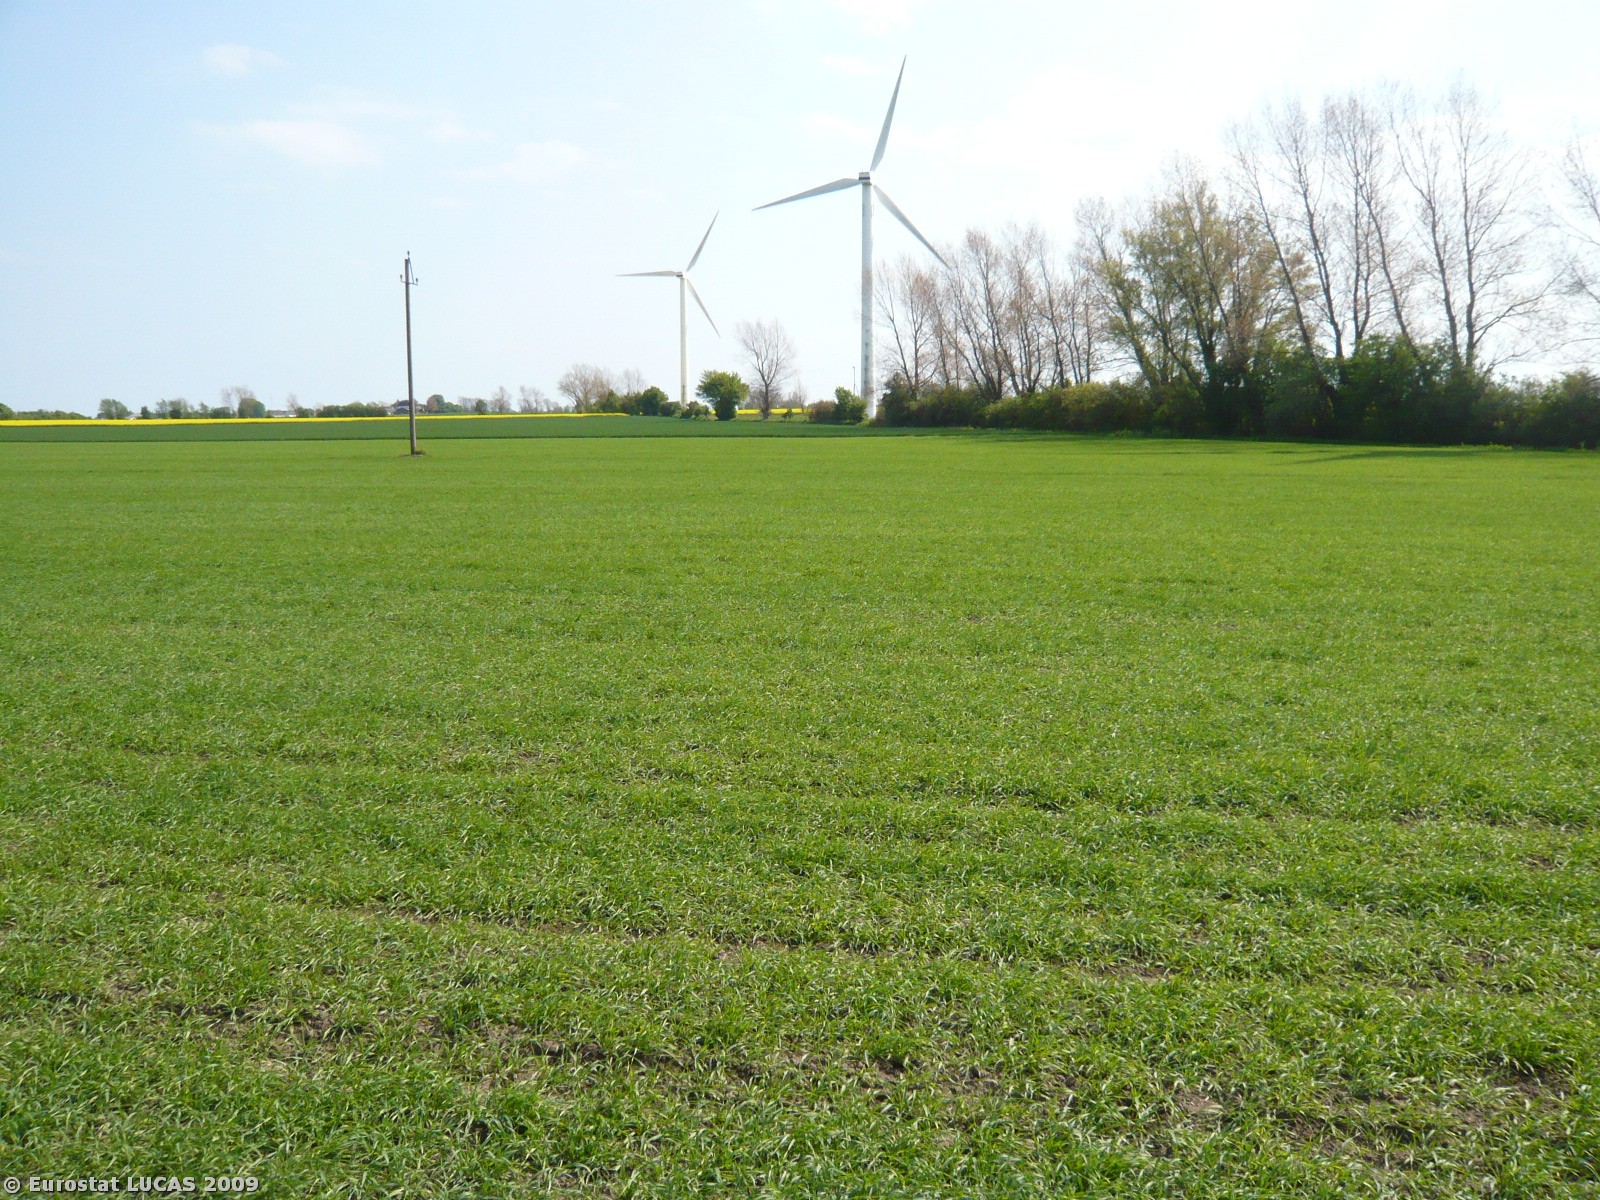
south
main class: Cropland
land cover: Barley
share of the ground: > 75 %
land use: Agriculture (excluding fallow land and kitchen gardens)
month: May
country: DK
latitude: 55.2684
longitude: 12.2805
